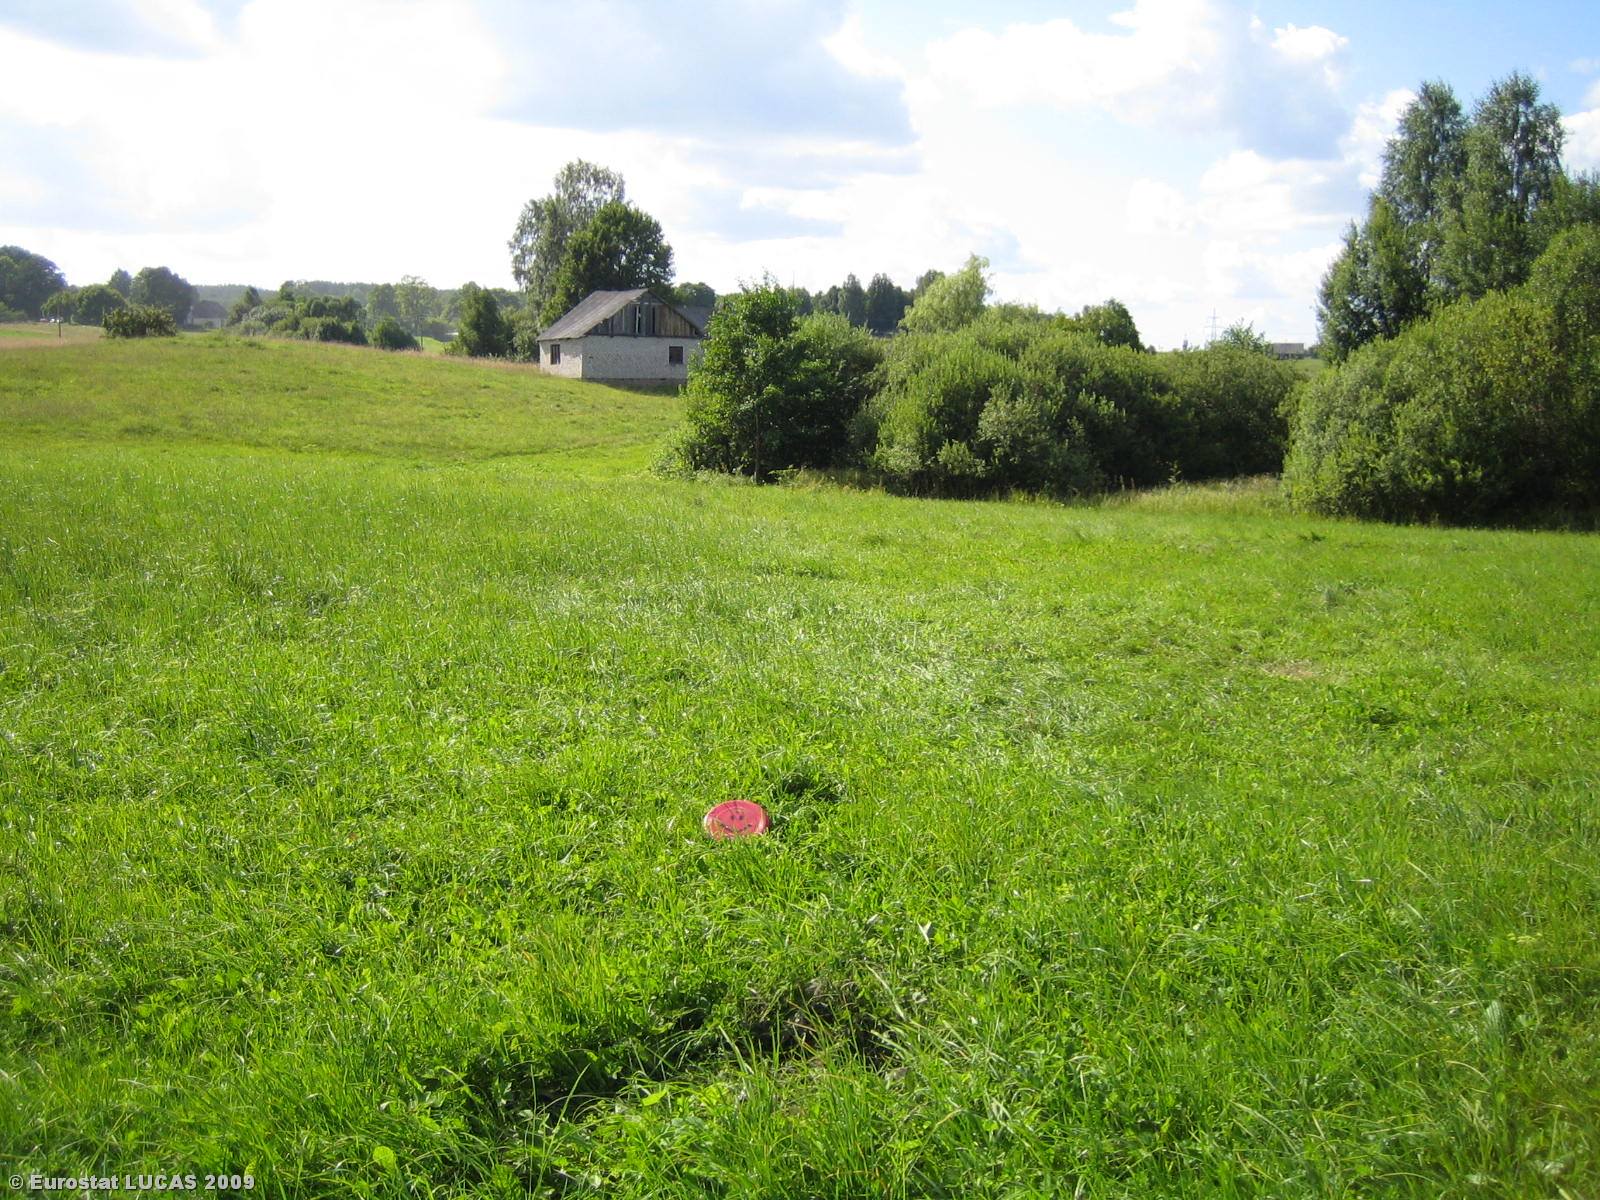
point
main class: Grassland
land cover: Grassland without tree/shrub cover
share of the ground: > 75 %
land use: Agriculture (excluding fallow land and kitchen gardens)
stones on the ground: < 10 %
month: August
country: LT
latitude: 54.7709
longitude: 24.5124
